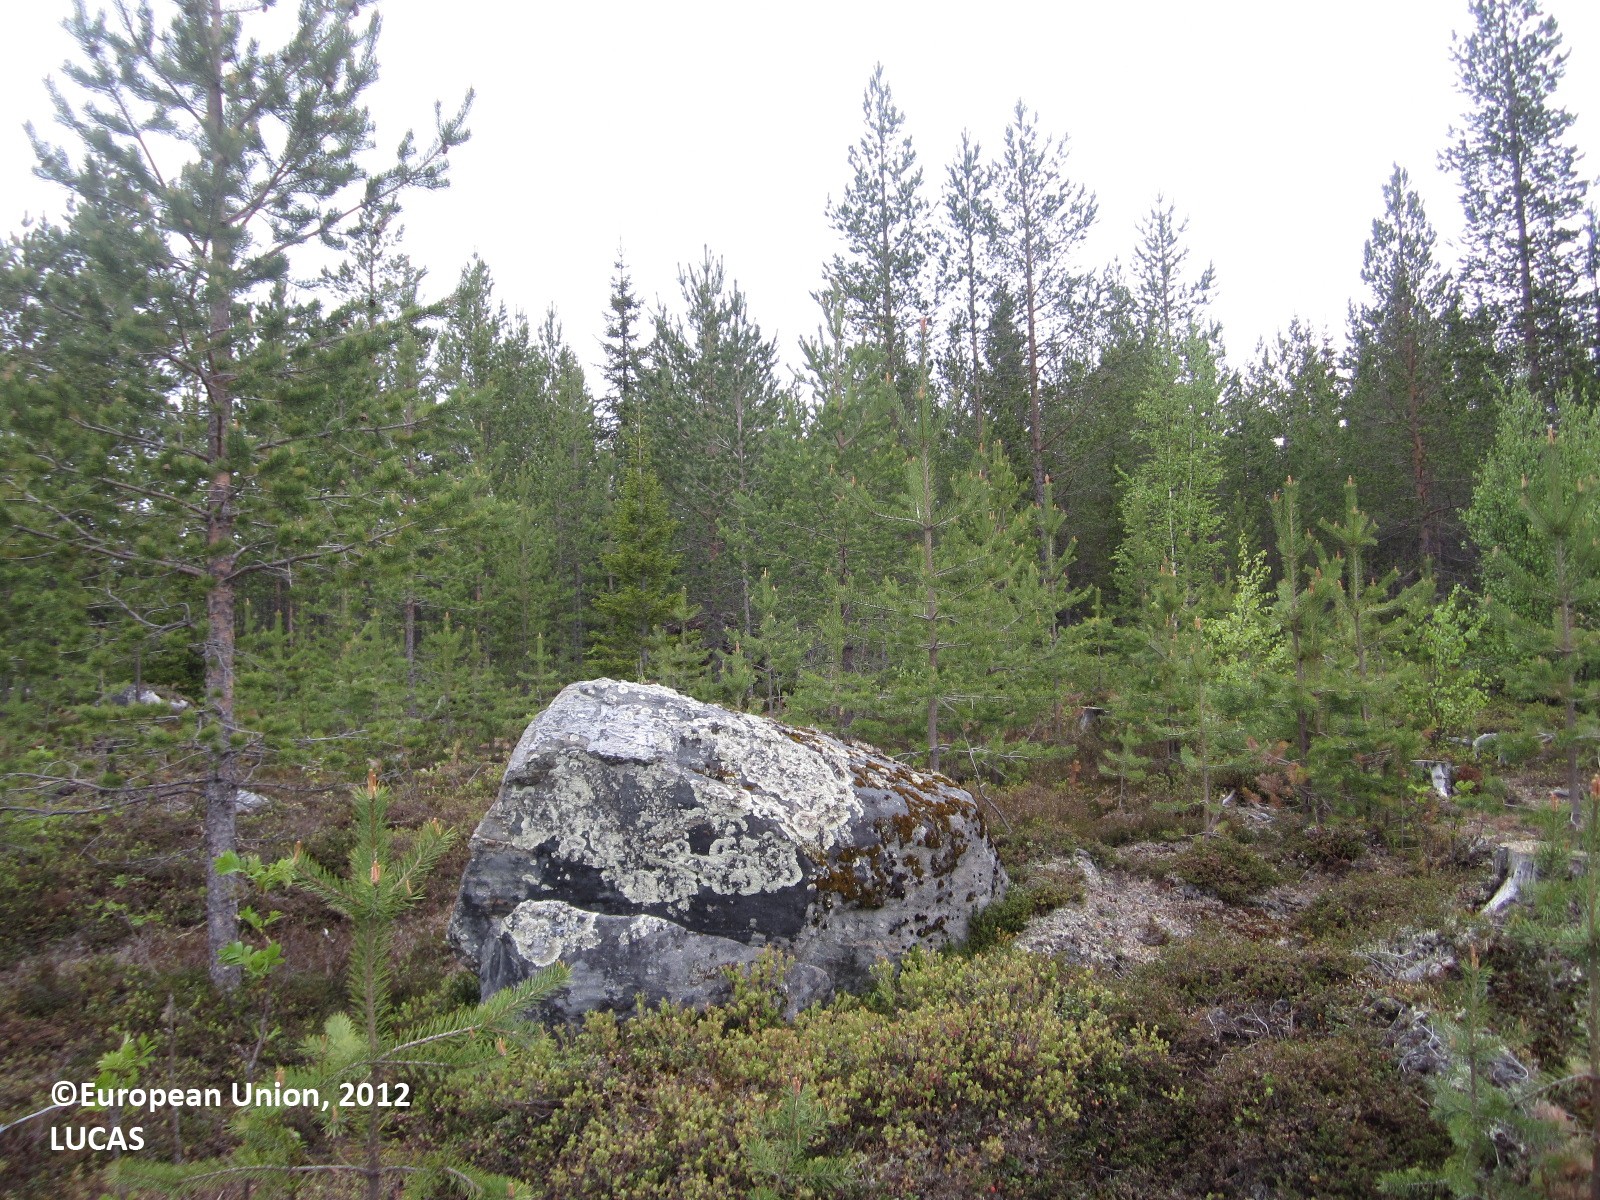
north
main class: Woodland
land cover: Pine dominated coniferous woodland
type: boreal forest
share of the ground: 10 - 25 %
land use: Forestry
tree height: < 5 m
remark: Clear cut
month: June
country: FI
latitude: 64.7459
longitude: 28.8610
